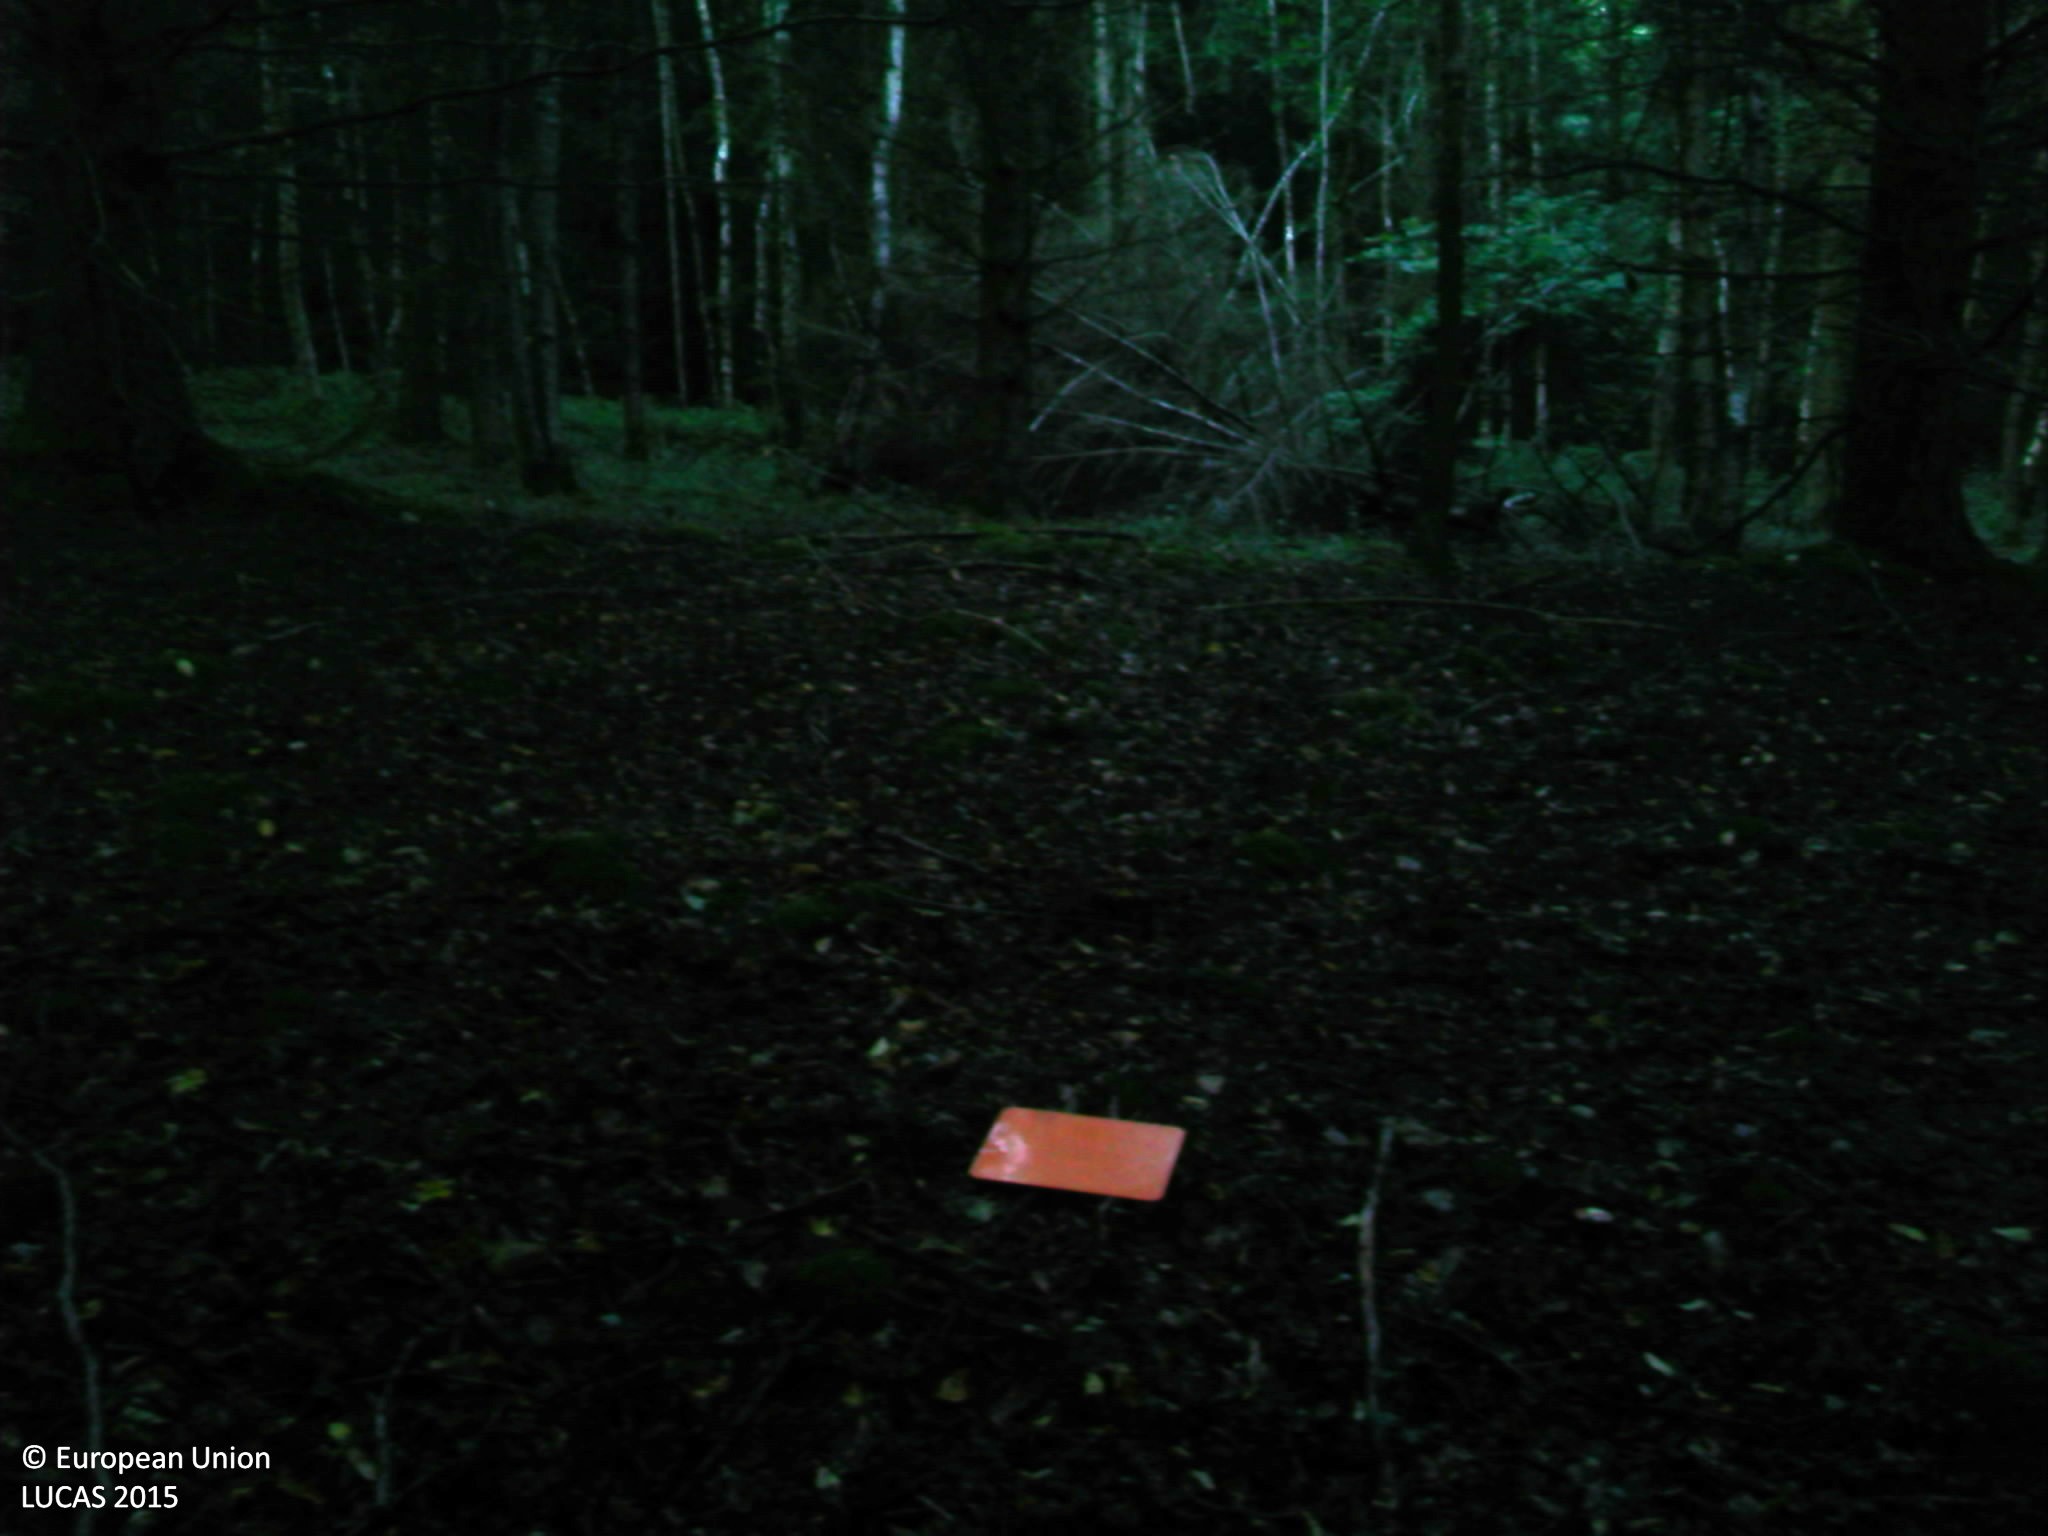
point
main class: Woodland
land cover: Spruce dominated mixed woodland
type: mesophytic deciduous forest
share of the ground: > 75 %
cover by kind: coniferous forest trees 45 %, broadleaved forest trees 25 %, shrubs 10 %, herbaceous plants 10 %, lichens and mosses 10 %
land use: Forestry
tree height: > 5 m
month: September
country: FR
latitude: 48.4714
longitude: 0.7936
